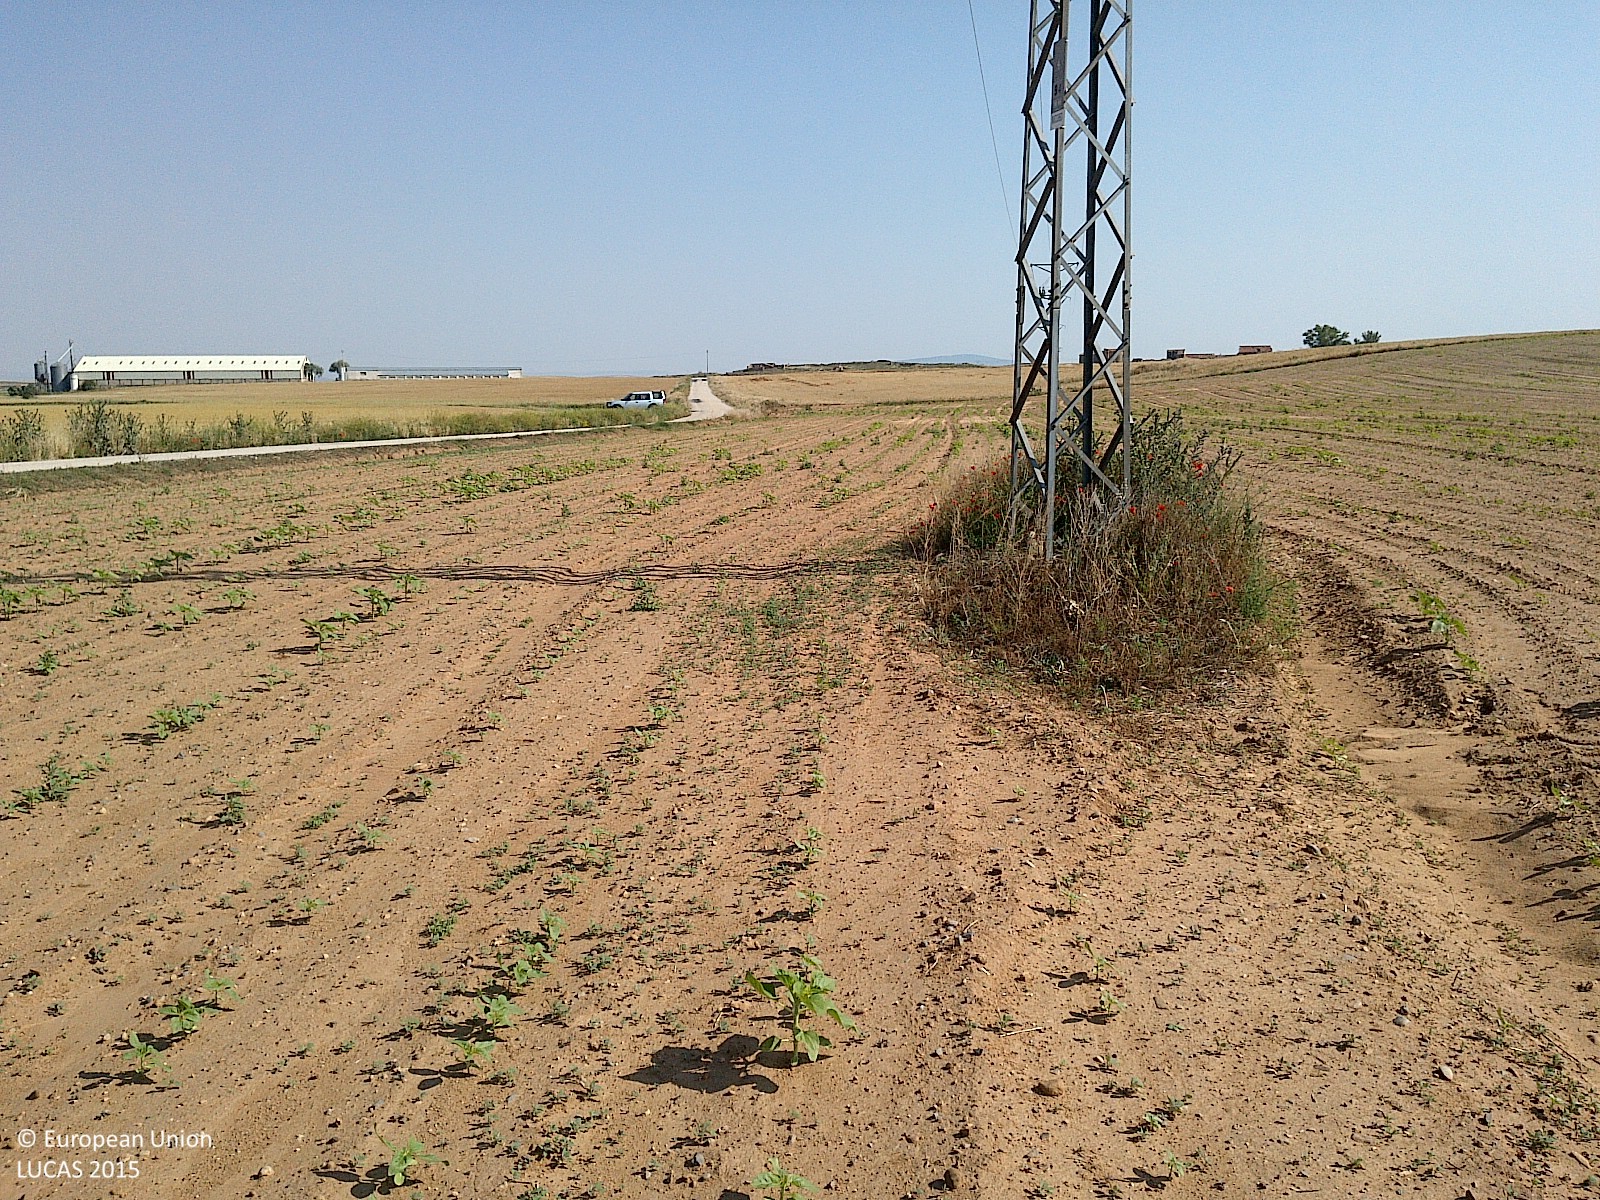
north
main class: Cropland
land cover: Sunflower
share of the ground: < 10 %
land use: Agriculture (excluding fallow land and kitchen gardens)
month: June
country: ES
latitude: 41.6139
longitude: -2.2626
